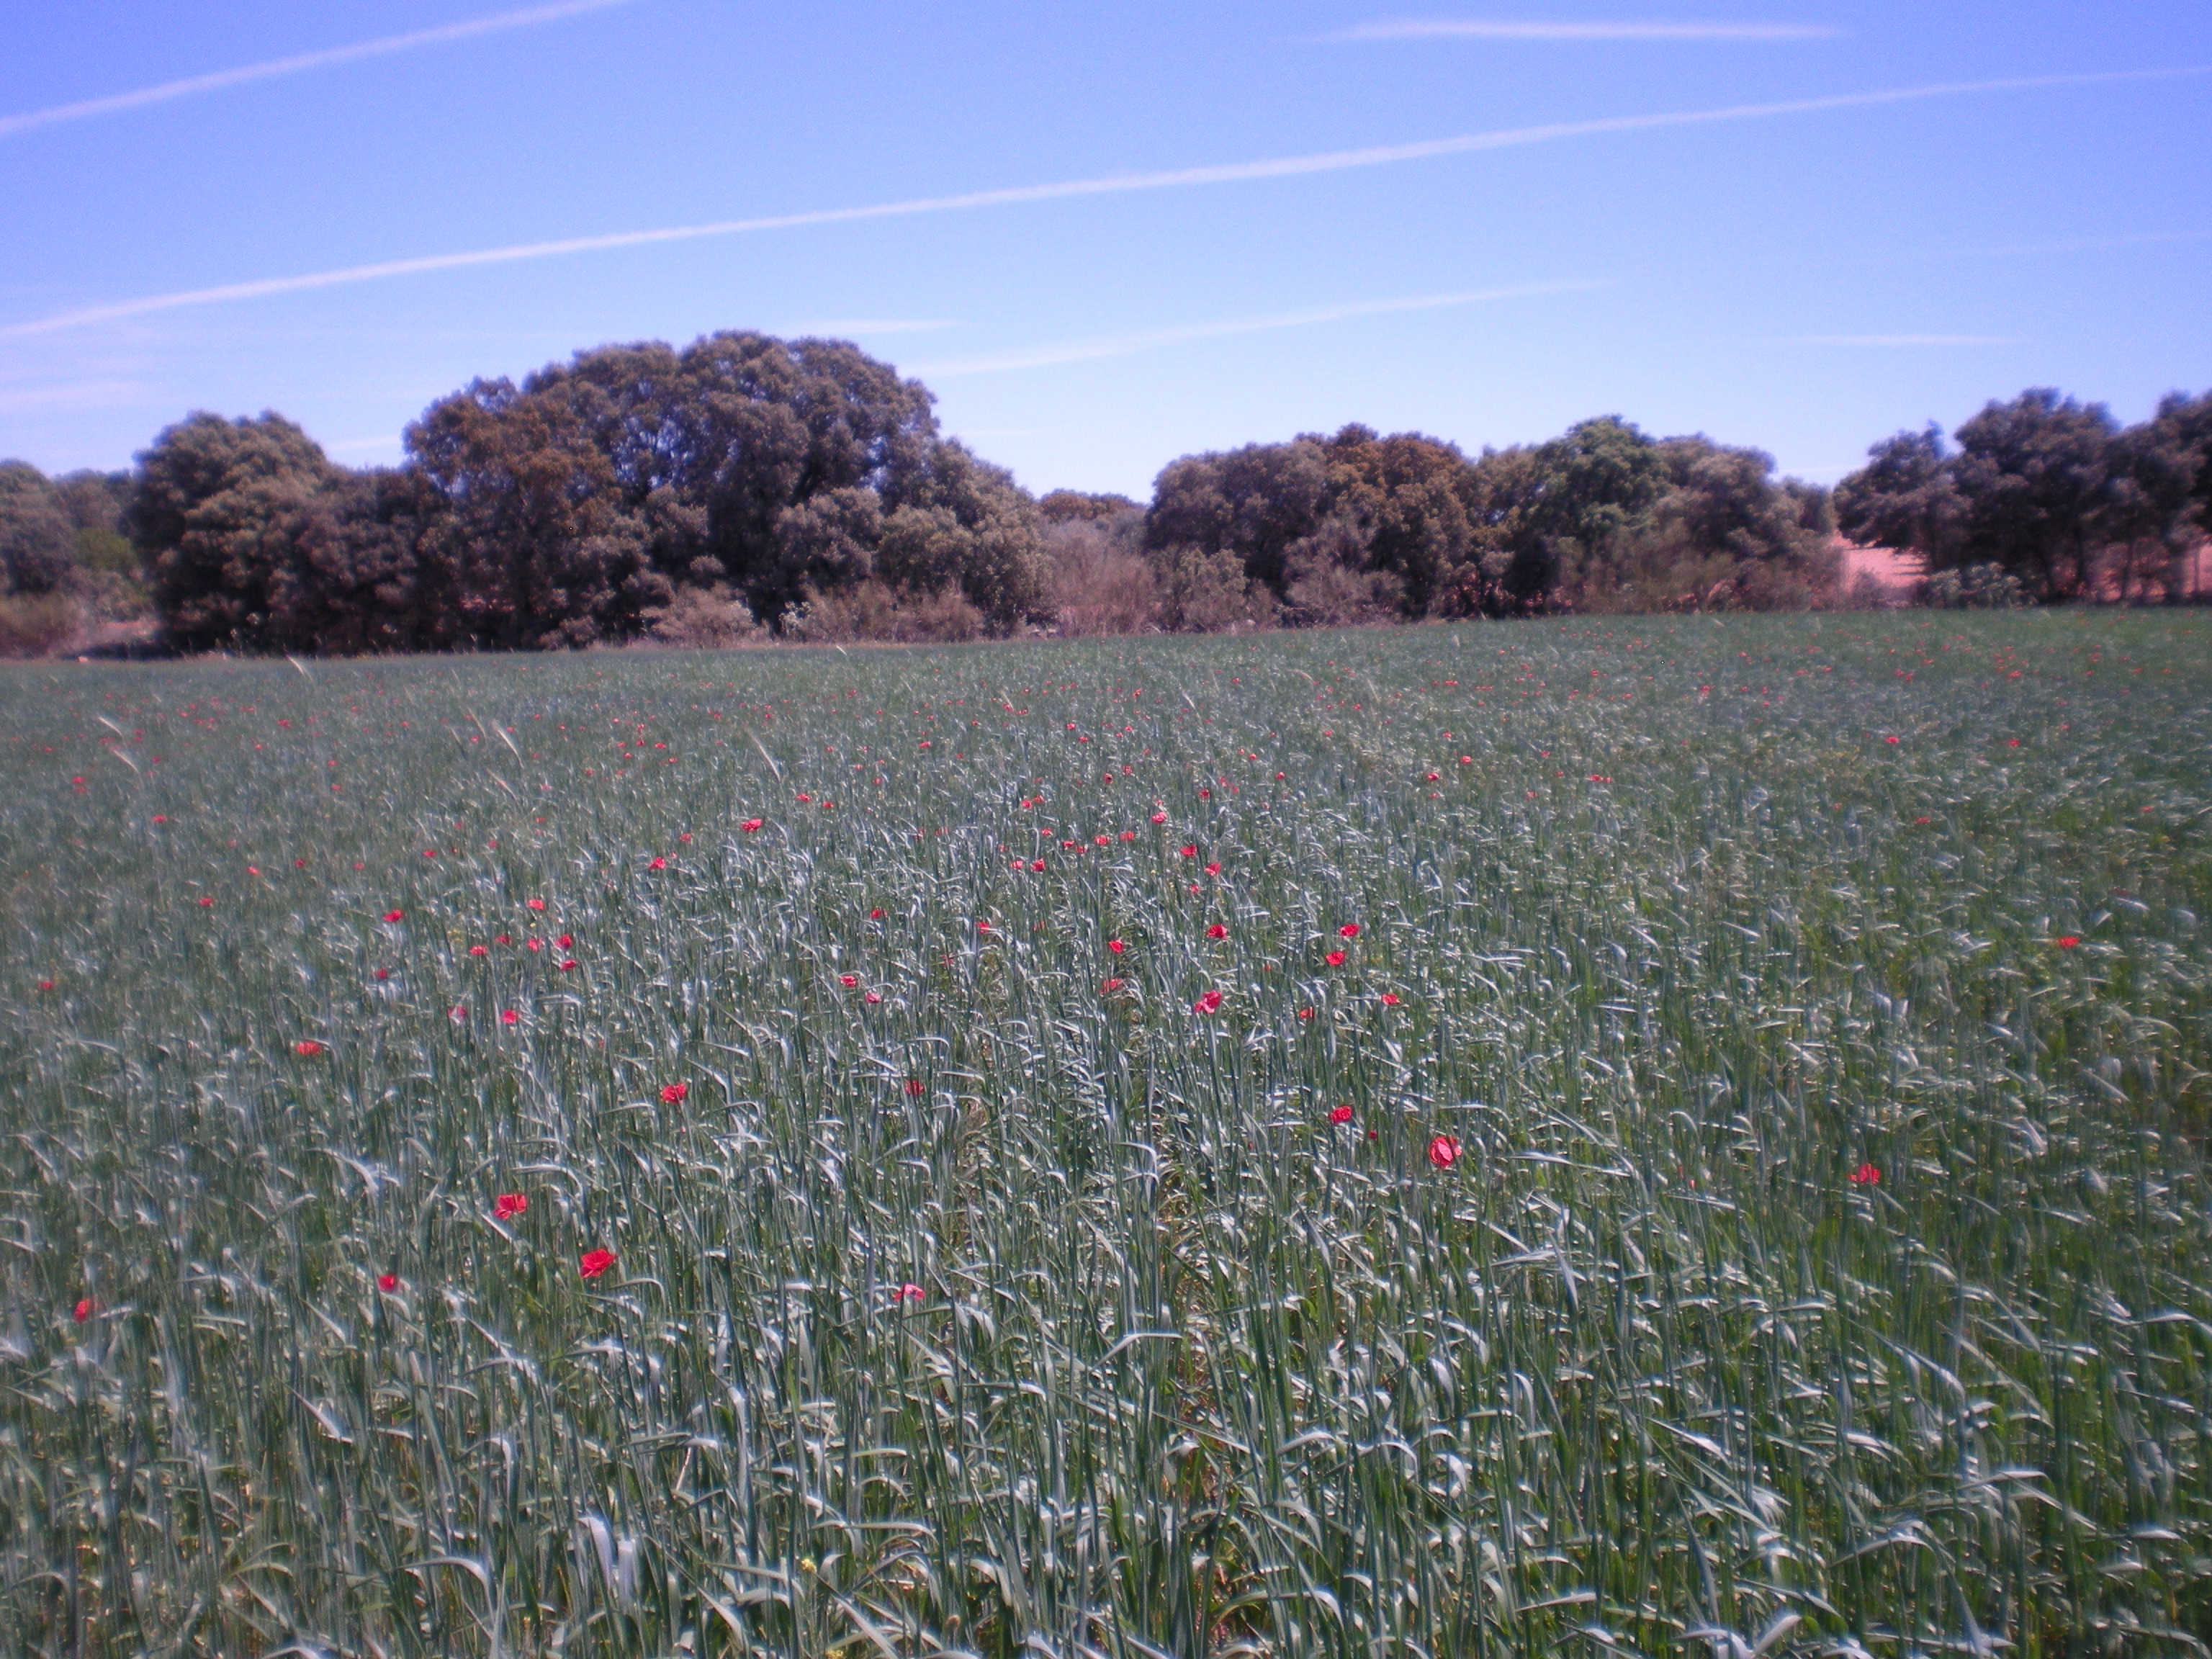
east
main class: Cropland
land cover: Common wheat
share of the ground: > 75 %
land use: Agriculture (excluding fallow land and kitchen gardens)
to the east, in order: Common wheat; Grass margins; Tracks; Grass margins; Broadleaved woodland; Olive groves; Broadleaved woodland
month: May
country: ES
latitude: 38.9895
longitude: -3.0449
